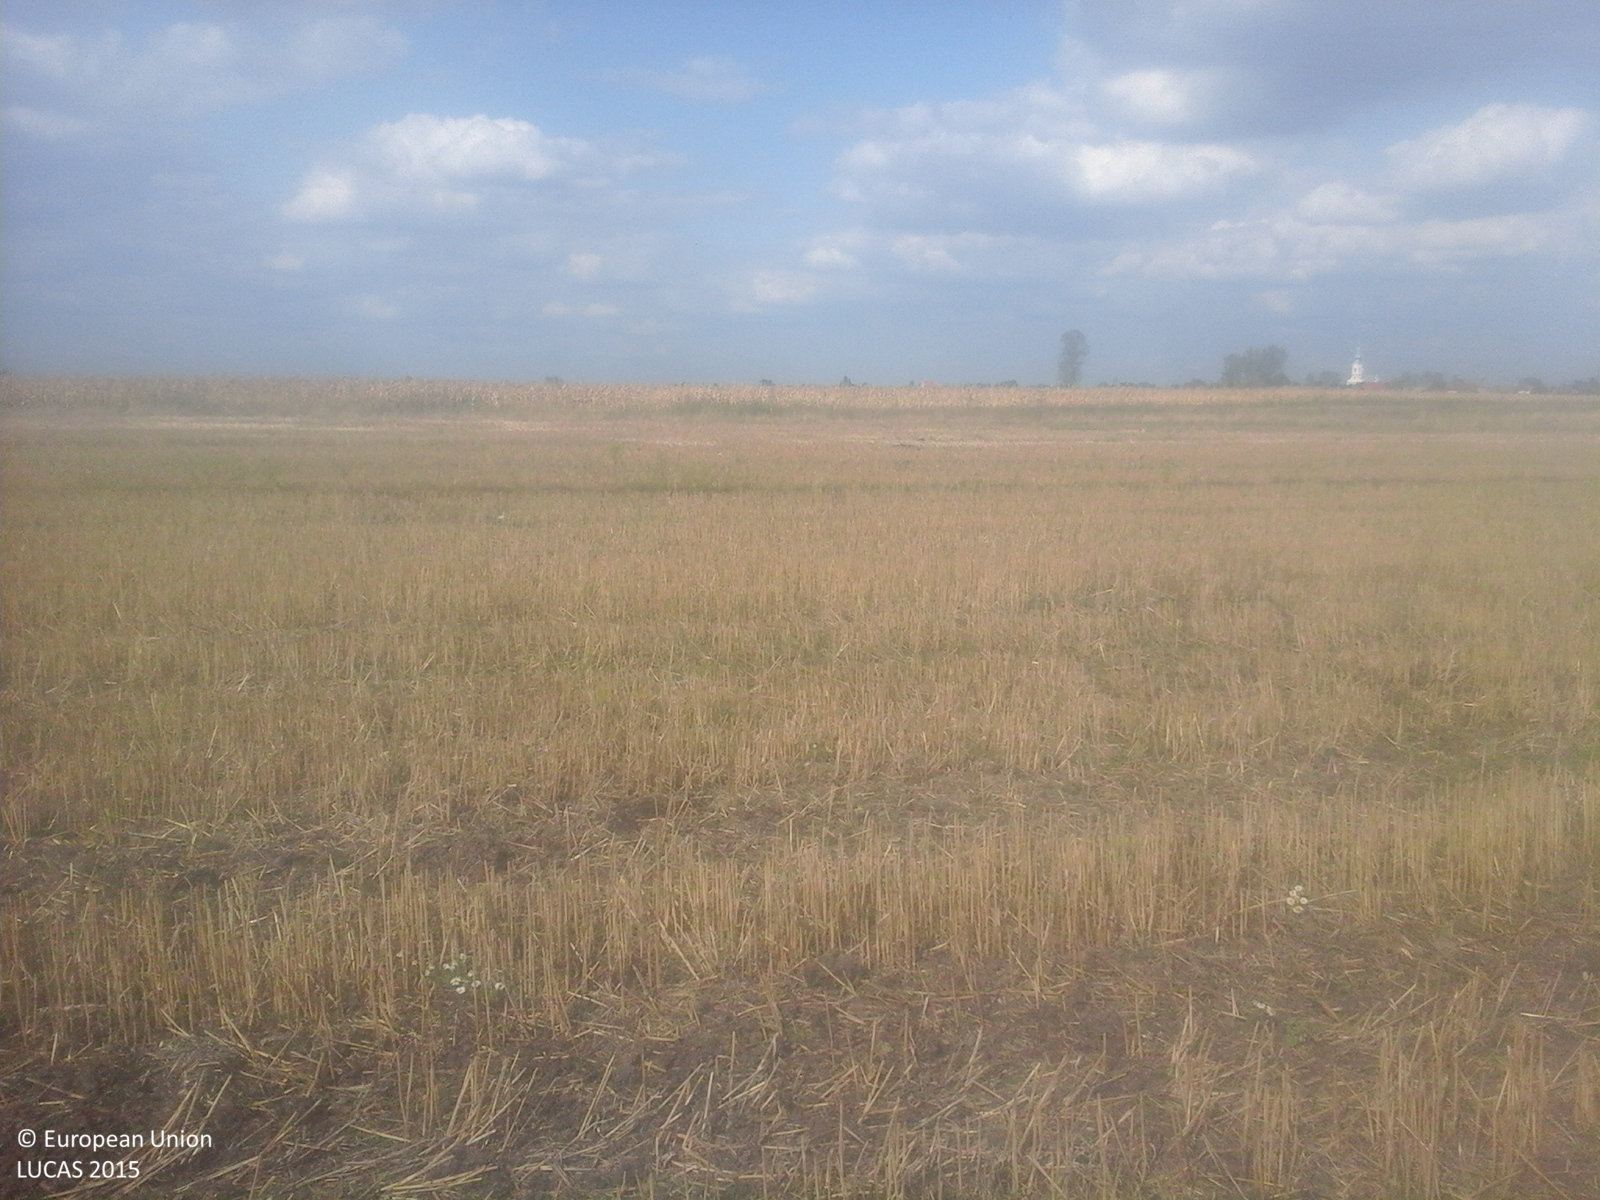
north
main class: Cropland
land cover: Common wheat
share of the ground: < 10 %
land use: Agriculture (excluding fallow land and kitchen gardens)
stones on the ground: < 10 %
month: September
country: RO
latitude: 47.6469
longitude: 22.7213
